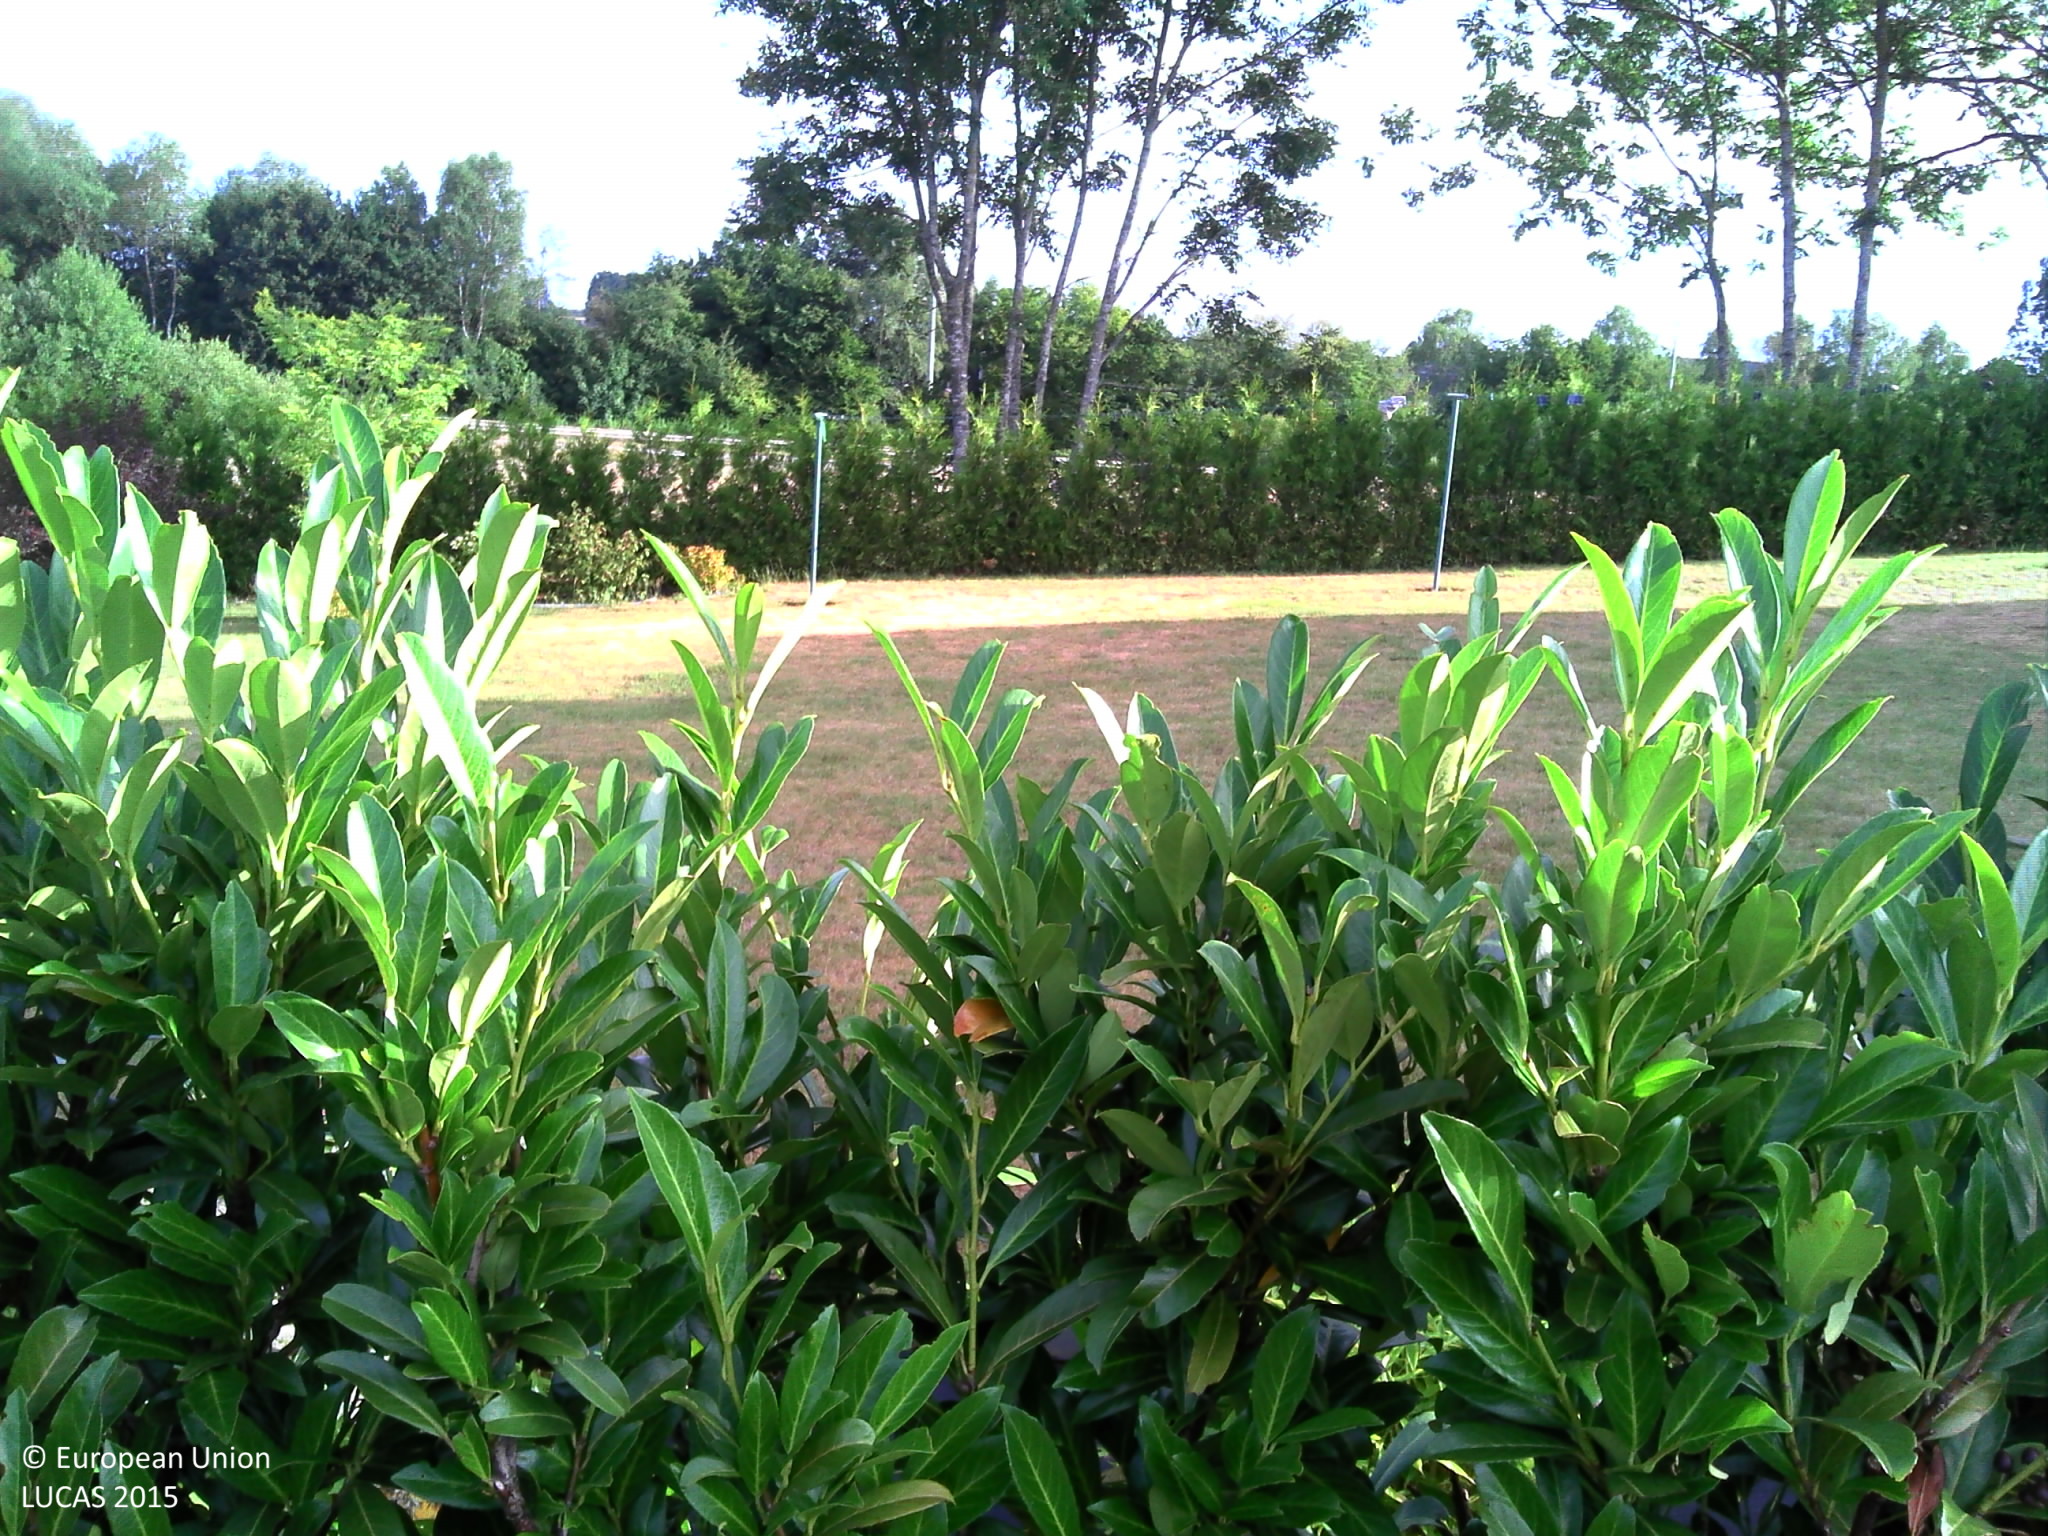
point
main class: Grassland
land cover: Grassland without tree/shrub cover
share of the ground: > 75 %
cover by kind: herbaceous plants 100 %
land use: Residential
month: July
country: BE
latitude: 49.6927
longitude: 5.7985
